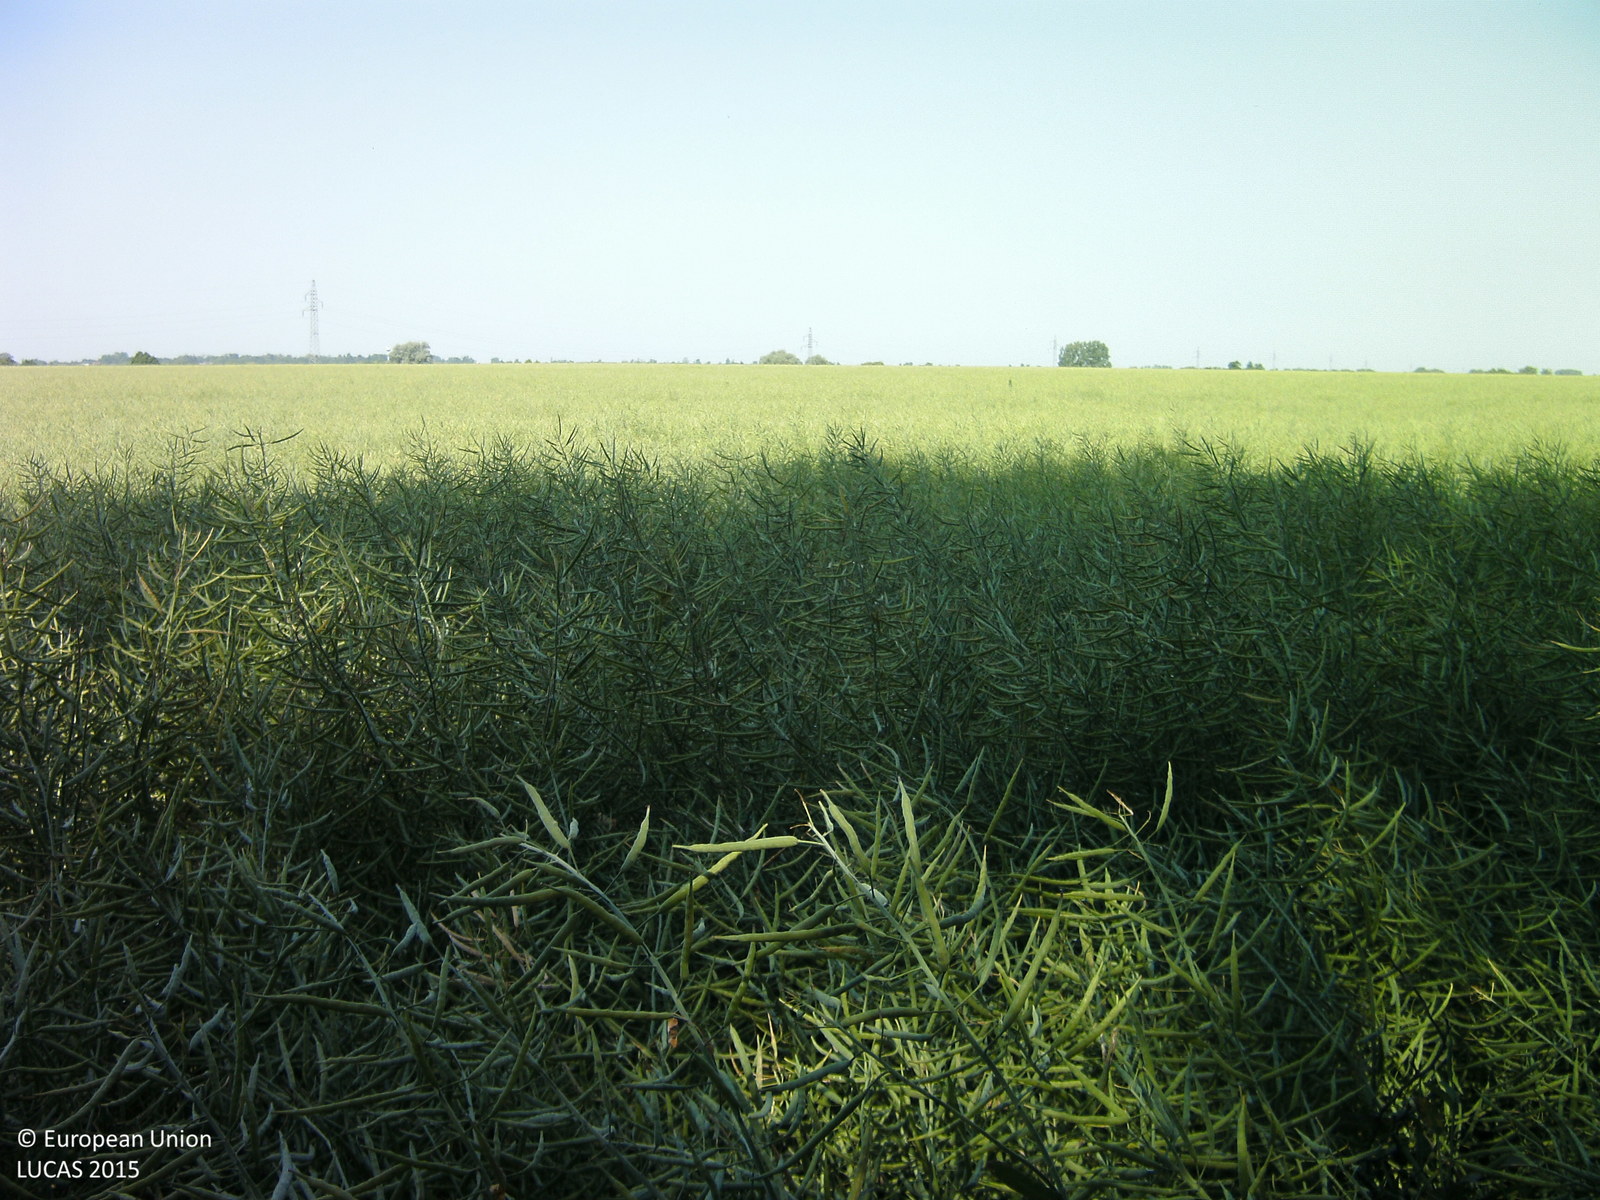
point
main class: Cropland
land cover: Rape and turnip rape
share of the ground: > 75 %
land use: Agriculture (excluding fallow land and kitchen gardens)
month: June
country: HU
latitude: 46.4464
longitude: 18.0392
